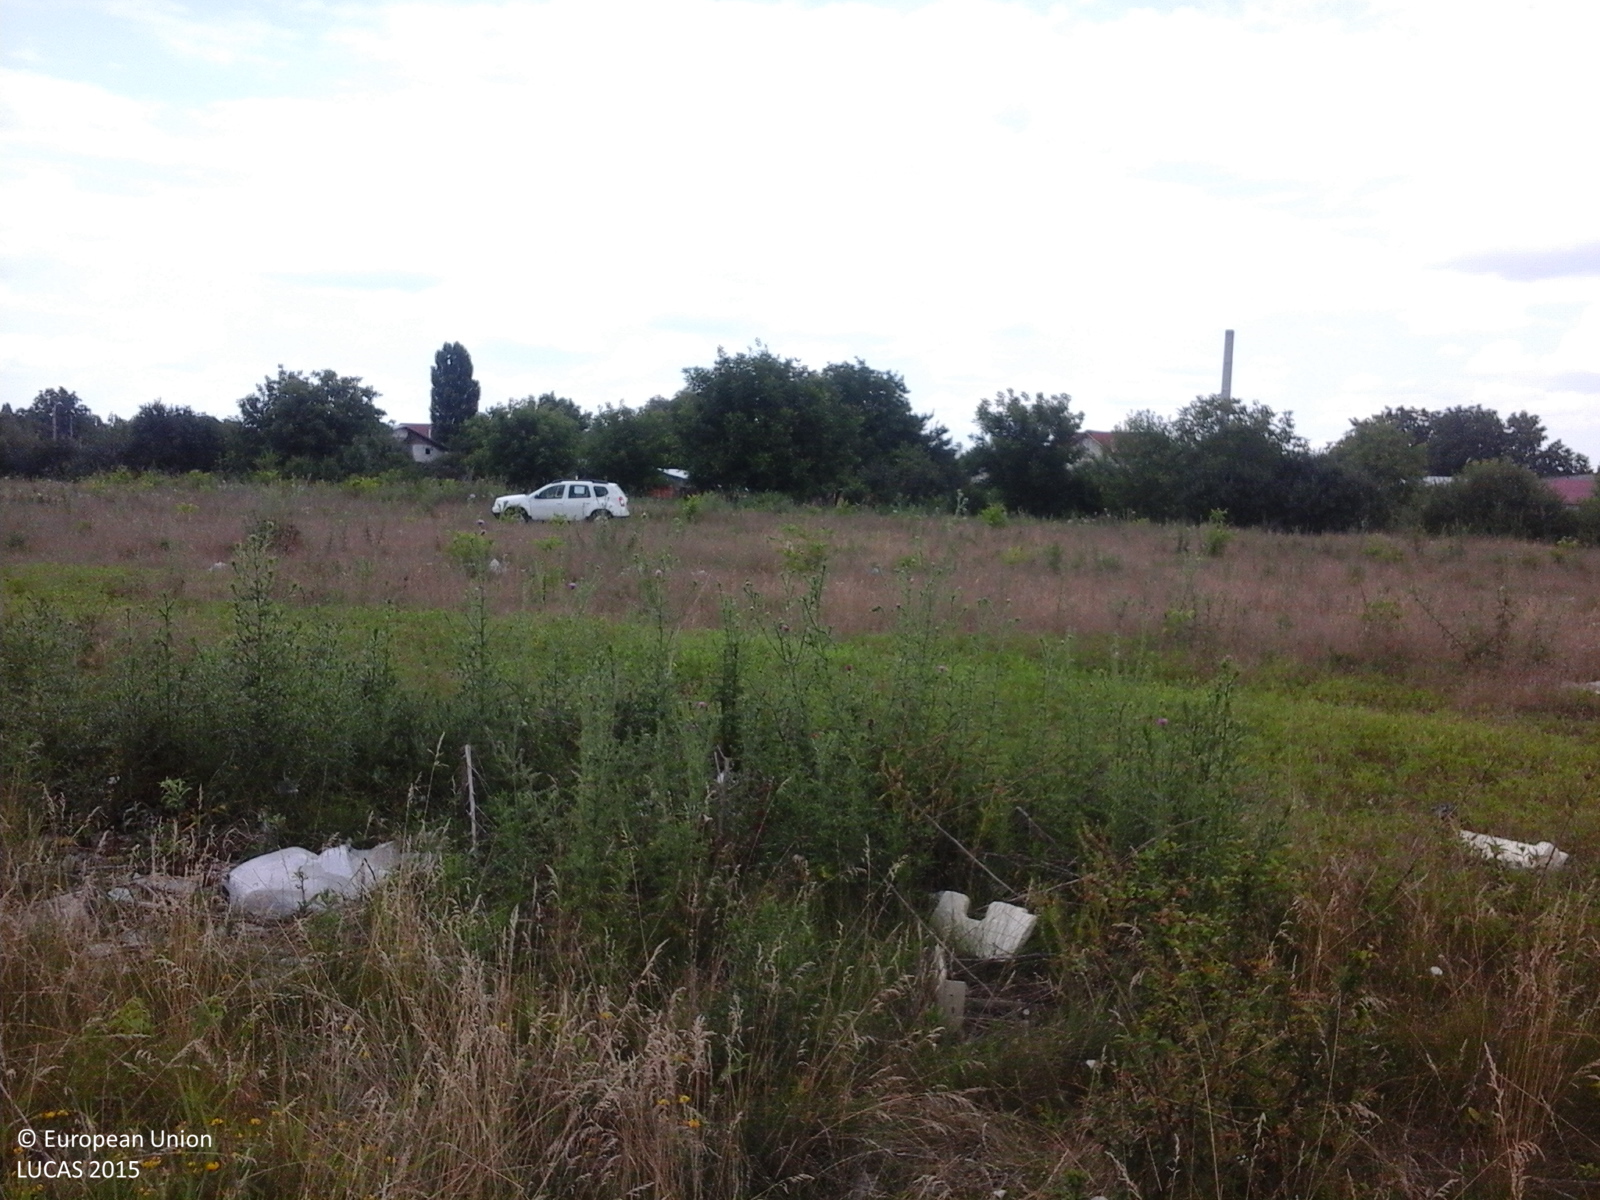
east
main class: Grassland
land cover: Grassland with sparse tree/shrub cover
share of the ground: > 75 %
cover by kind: herbaceous plants 85 %, shrubs 10 %, broadleaved forest trees 5 %
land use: Agriculture (excluding fallow land and kitchen gardens)
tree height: < 5 m
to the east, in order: Grassland with sparse tree/shrub cover; Lines of trees; Maize; Potatoes; Vineyards; Fences; Arable land (only in case pi); Artificial constructions in urban areas
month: June
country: RO
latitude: 44.3720
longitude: 26.0795
